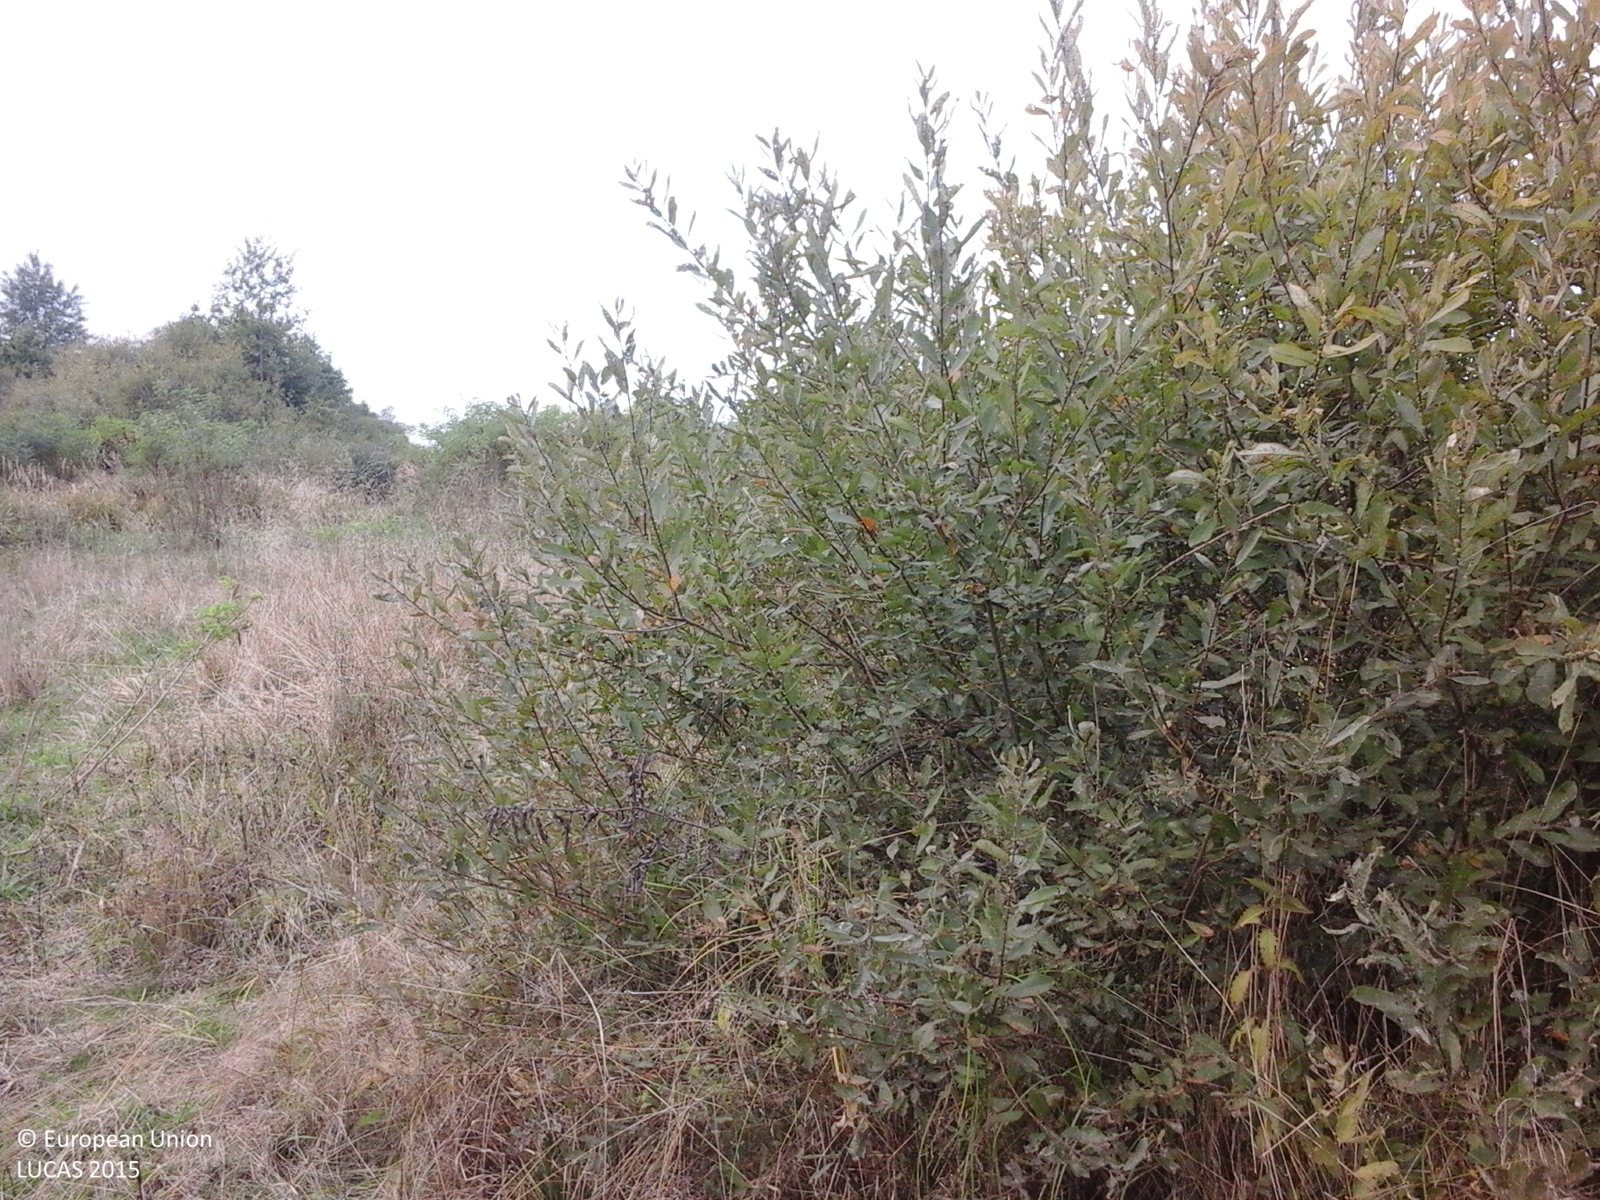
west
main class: Shrubland
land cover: Shrubland without tree cover
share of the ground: > 75 %
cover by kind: shrubs 100 %
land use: Semi-natural and natural areas not in use
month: September
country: RO
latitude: 45.9788
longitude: 22.1899
